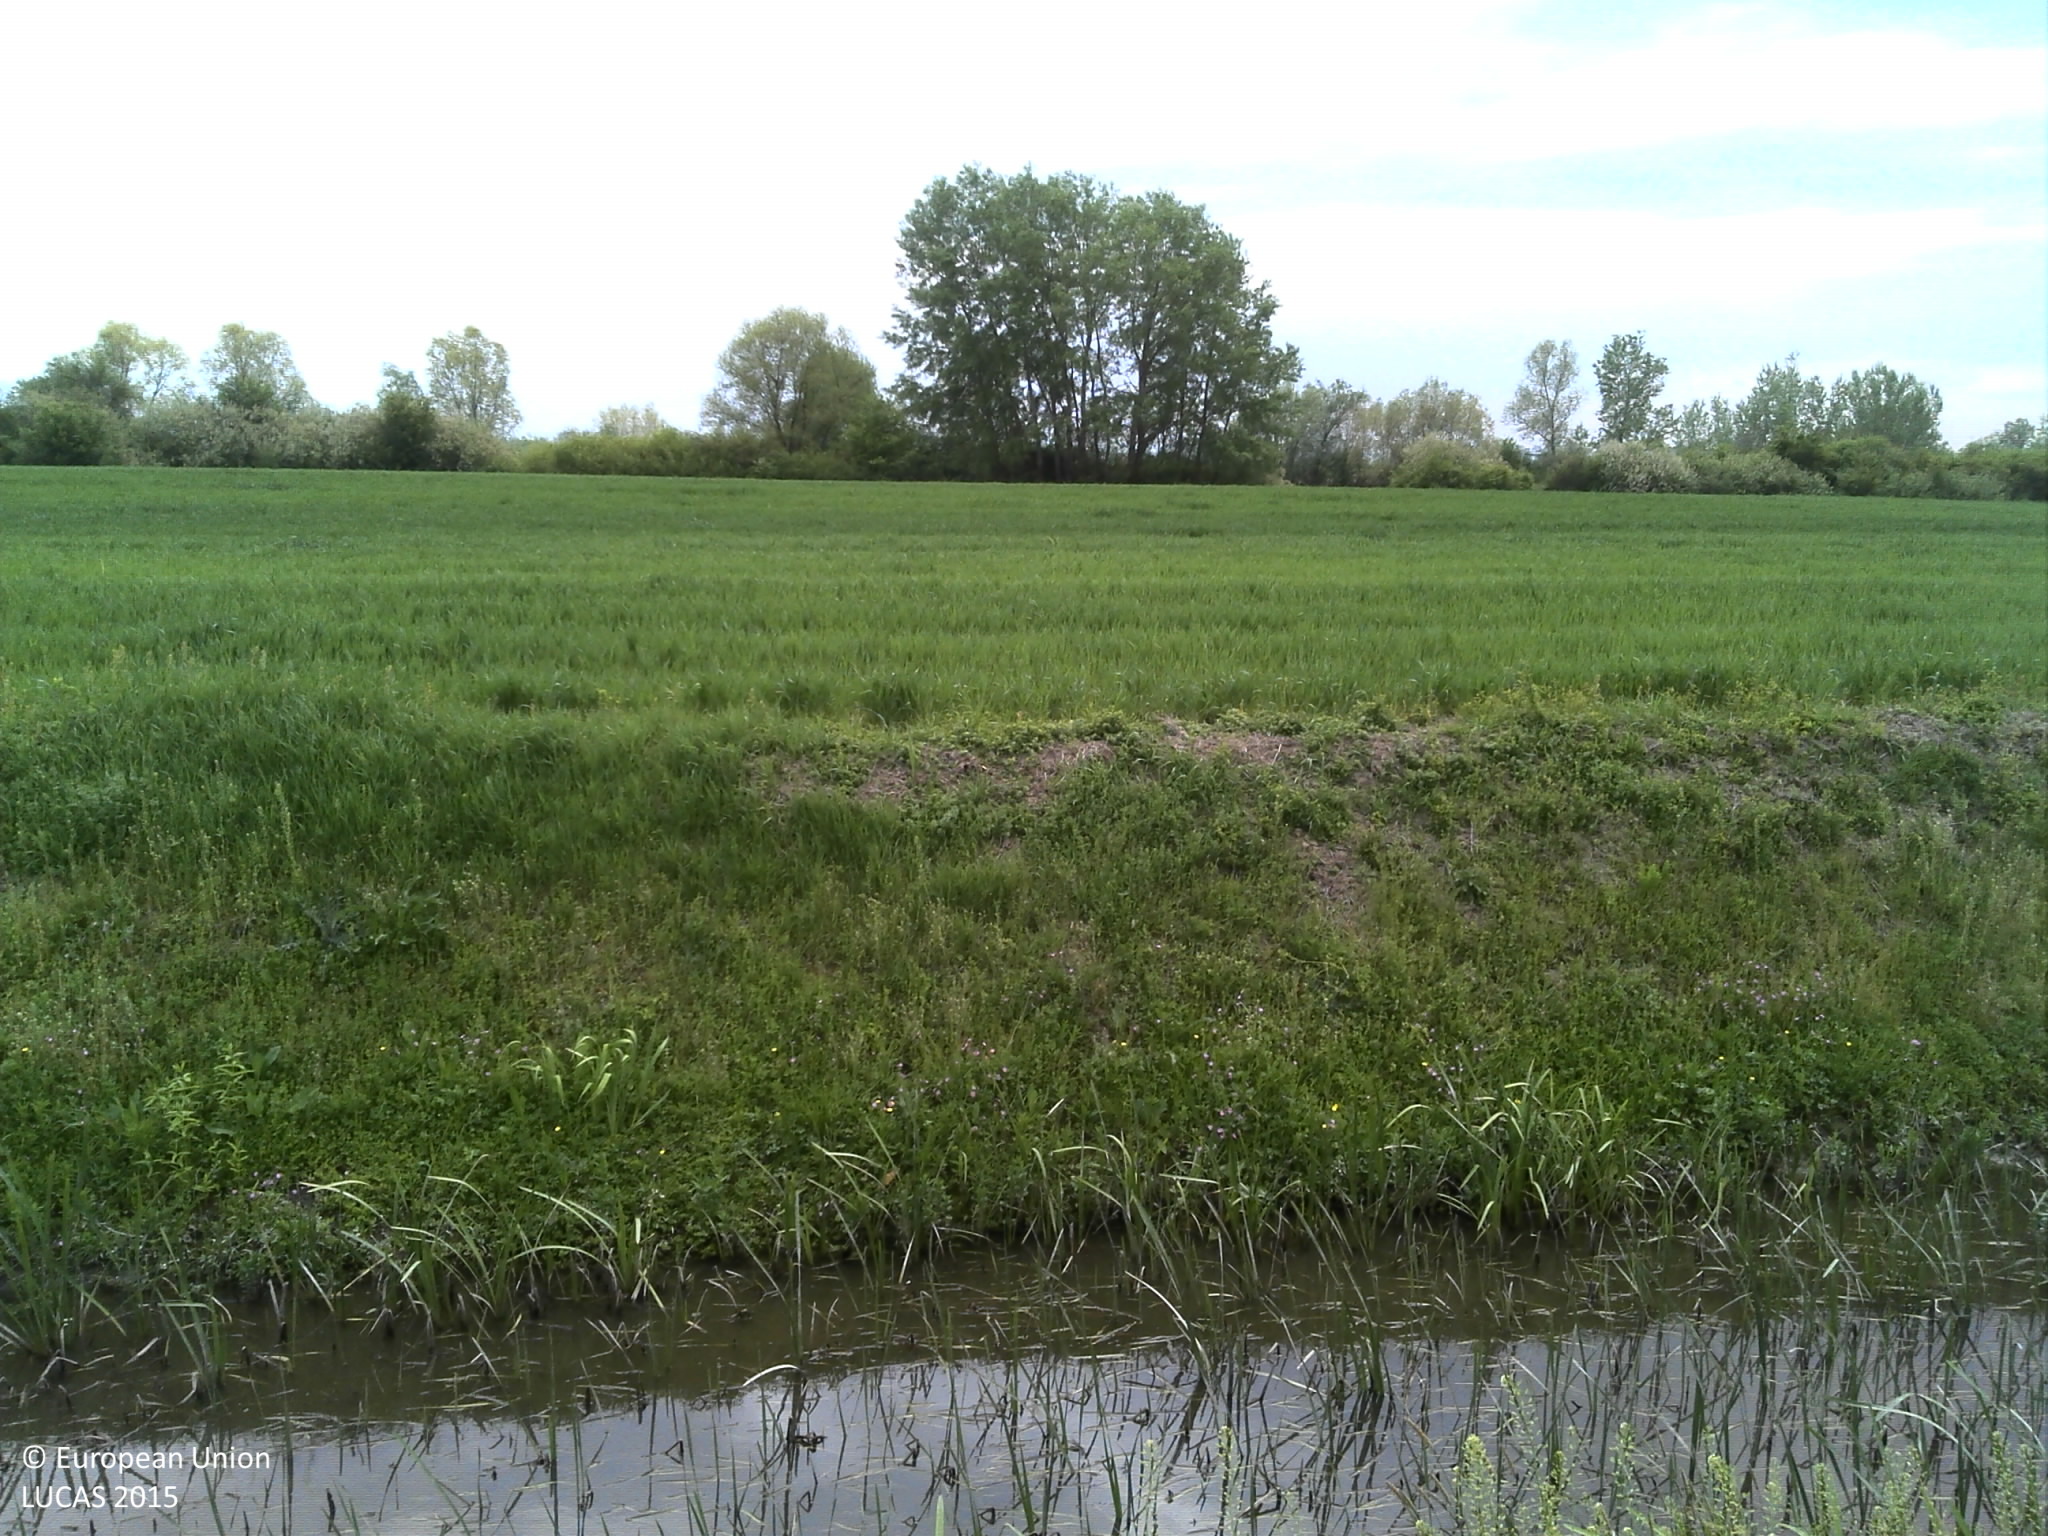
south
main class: Cropland
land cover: Soya
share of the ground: < 10 %
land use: Agriculture (excluding fallow land and kitchen gardens)
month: April
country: HR
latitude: 44.9610
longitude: 18.9440
